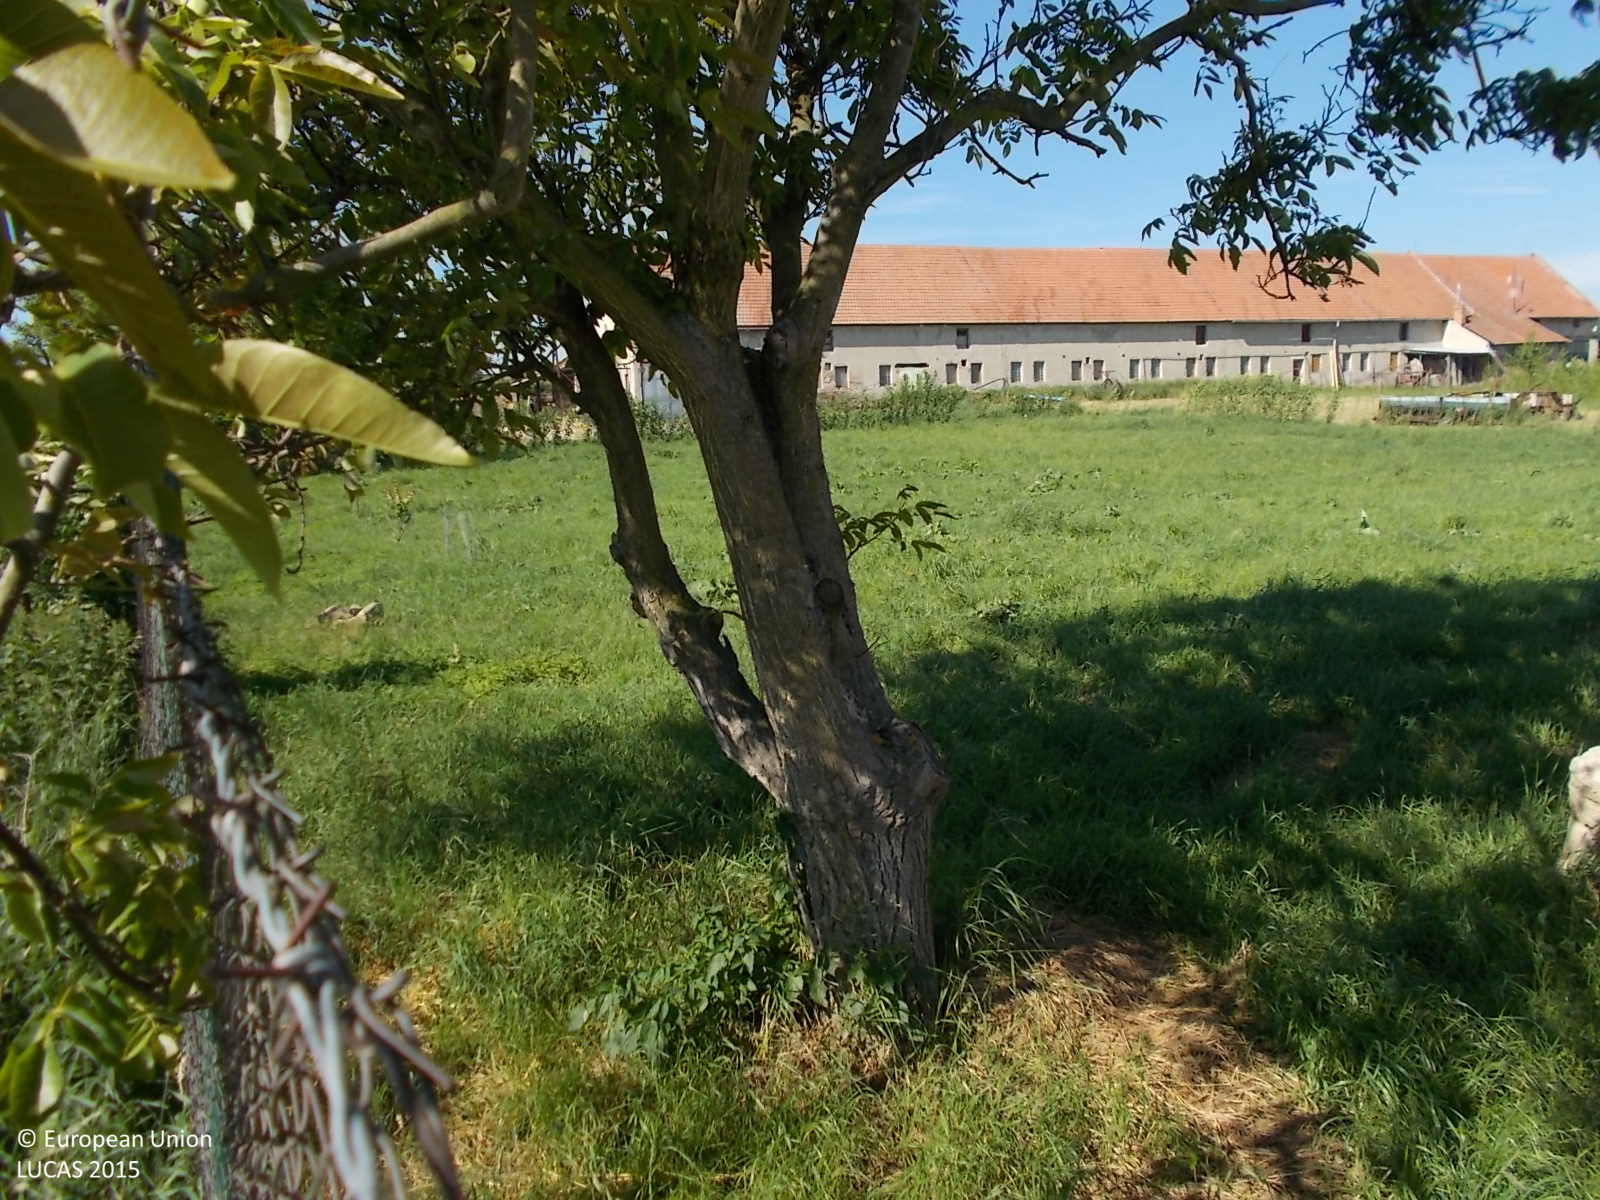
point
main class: Grassland
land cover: Grassland with sparse tree/shrub cover
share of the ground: > 75 %
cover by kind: herbaceous plants 90 %, broadleaved forest trees 5 %, shrubs 5 %
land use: Agriculture (excluding fallow land and kitchen gardens)
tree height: > 5 m
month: June
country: CZ
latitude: 49.3848
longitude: 17.1042
